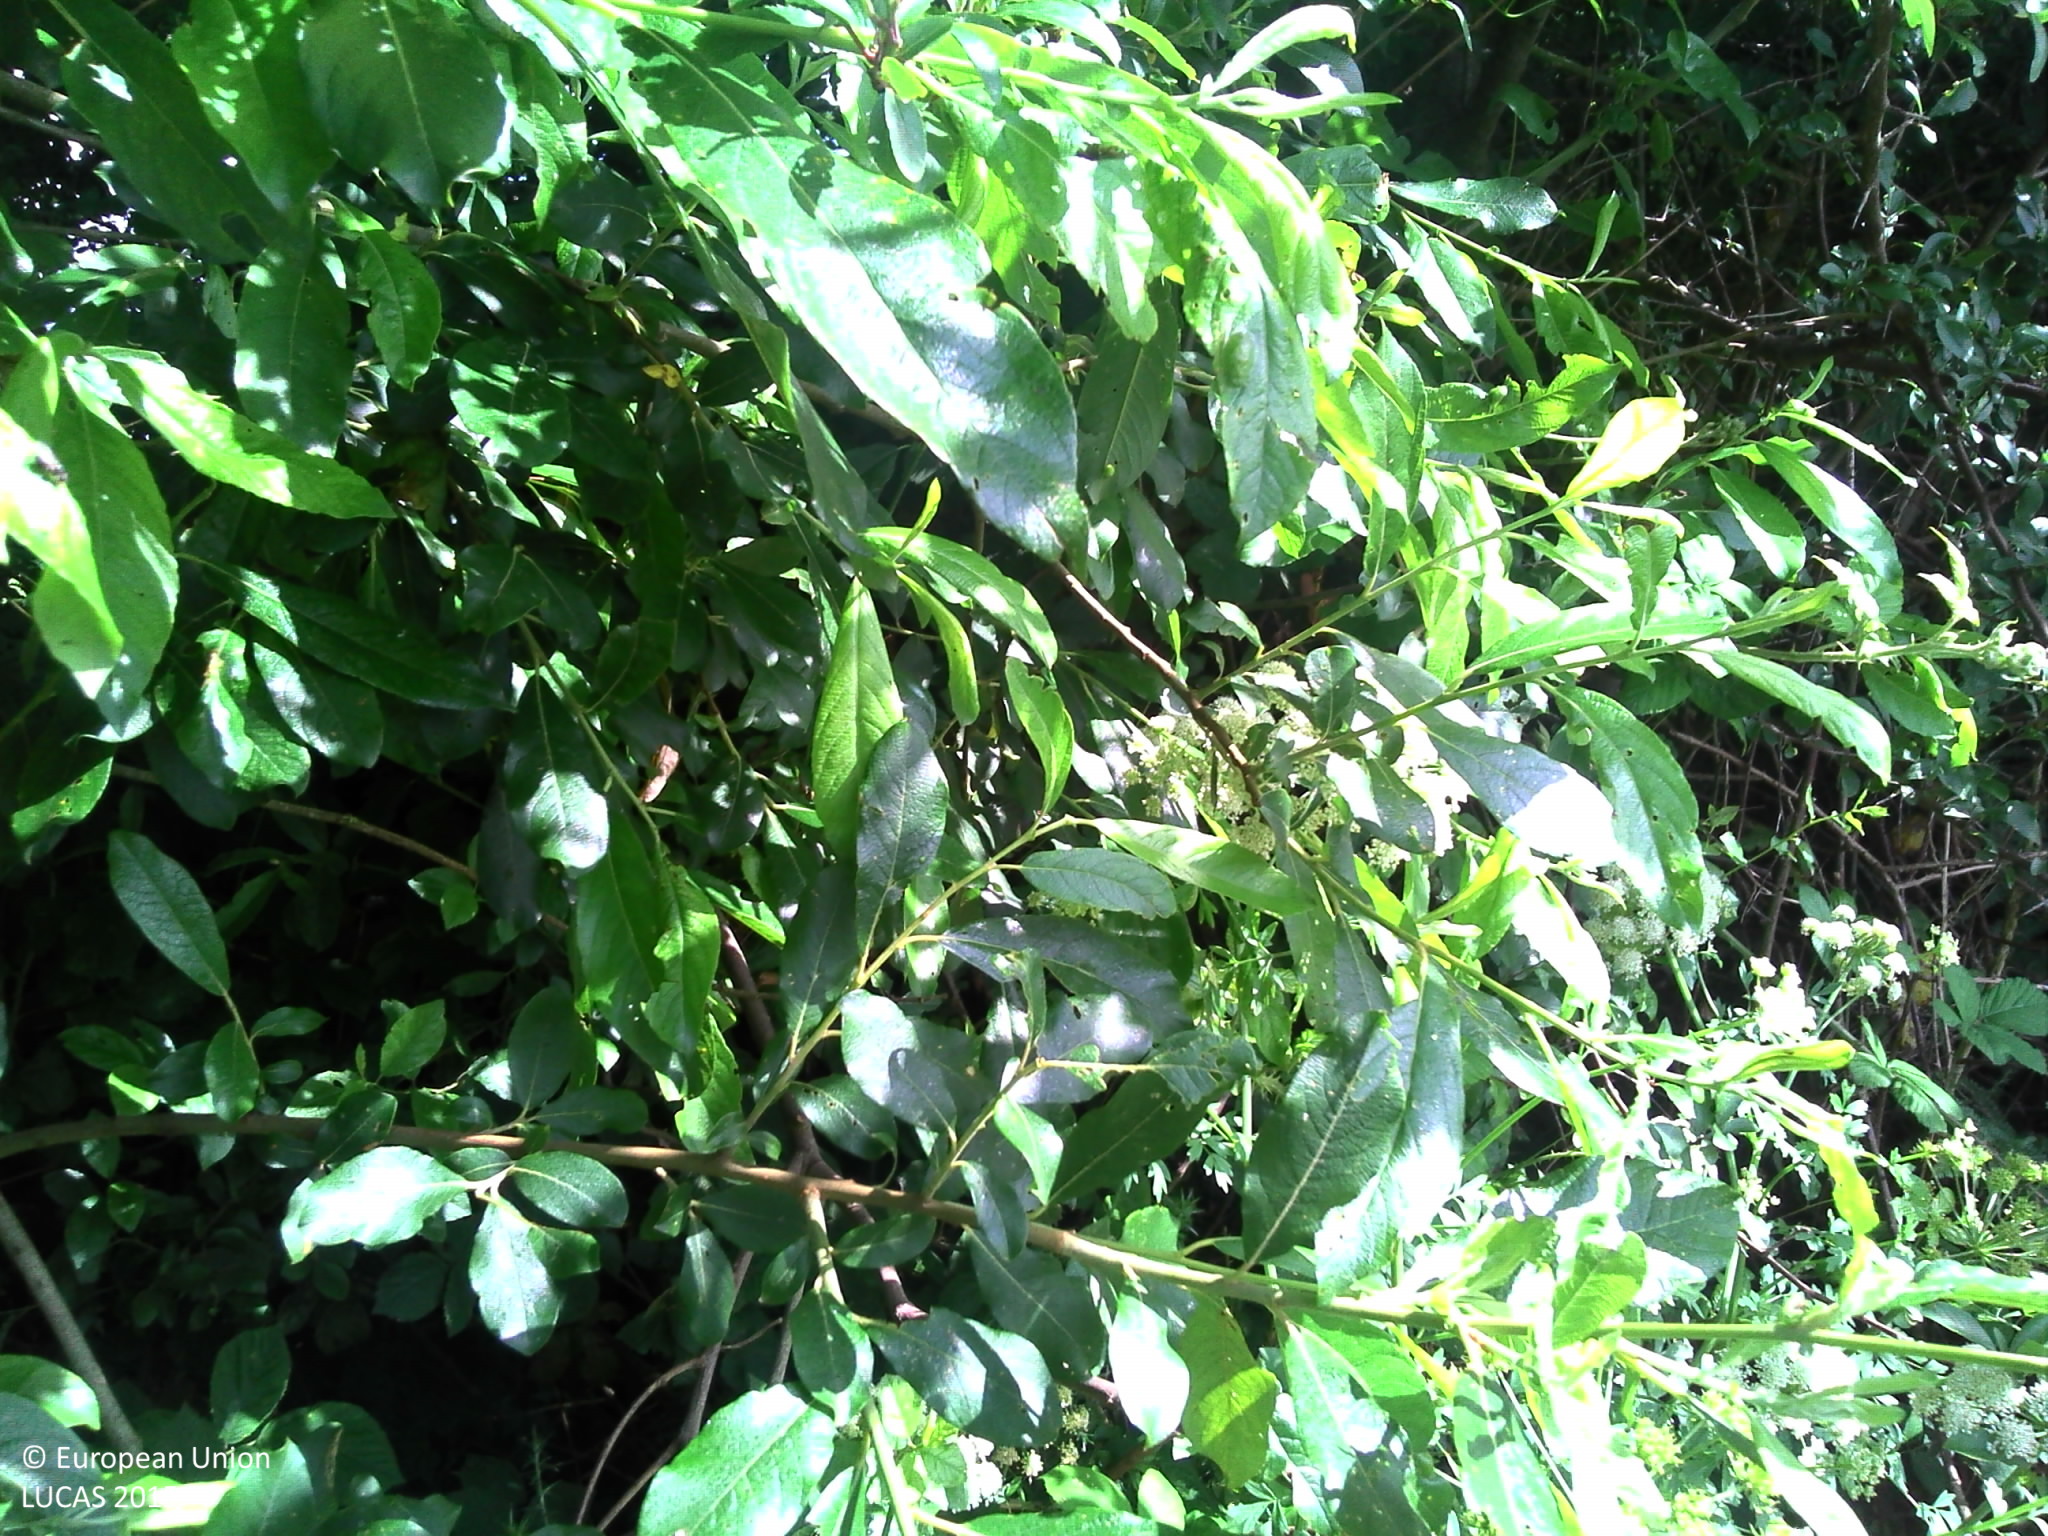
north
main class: Woodland
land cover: Broadleaved woodland
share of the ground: > 75 %
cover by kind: broadleaved forest trees 90 %, herbaceous plants 10 %
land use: Forestry
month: June
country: FR
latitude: 49.2733
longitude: -1.4981
